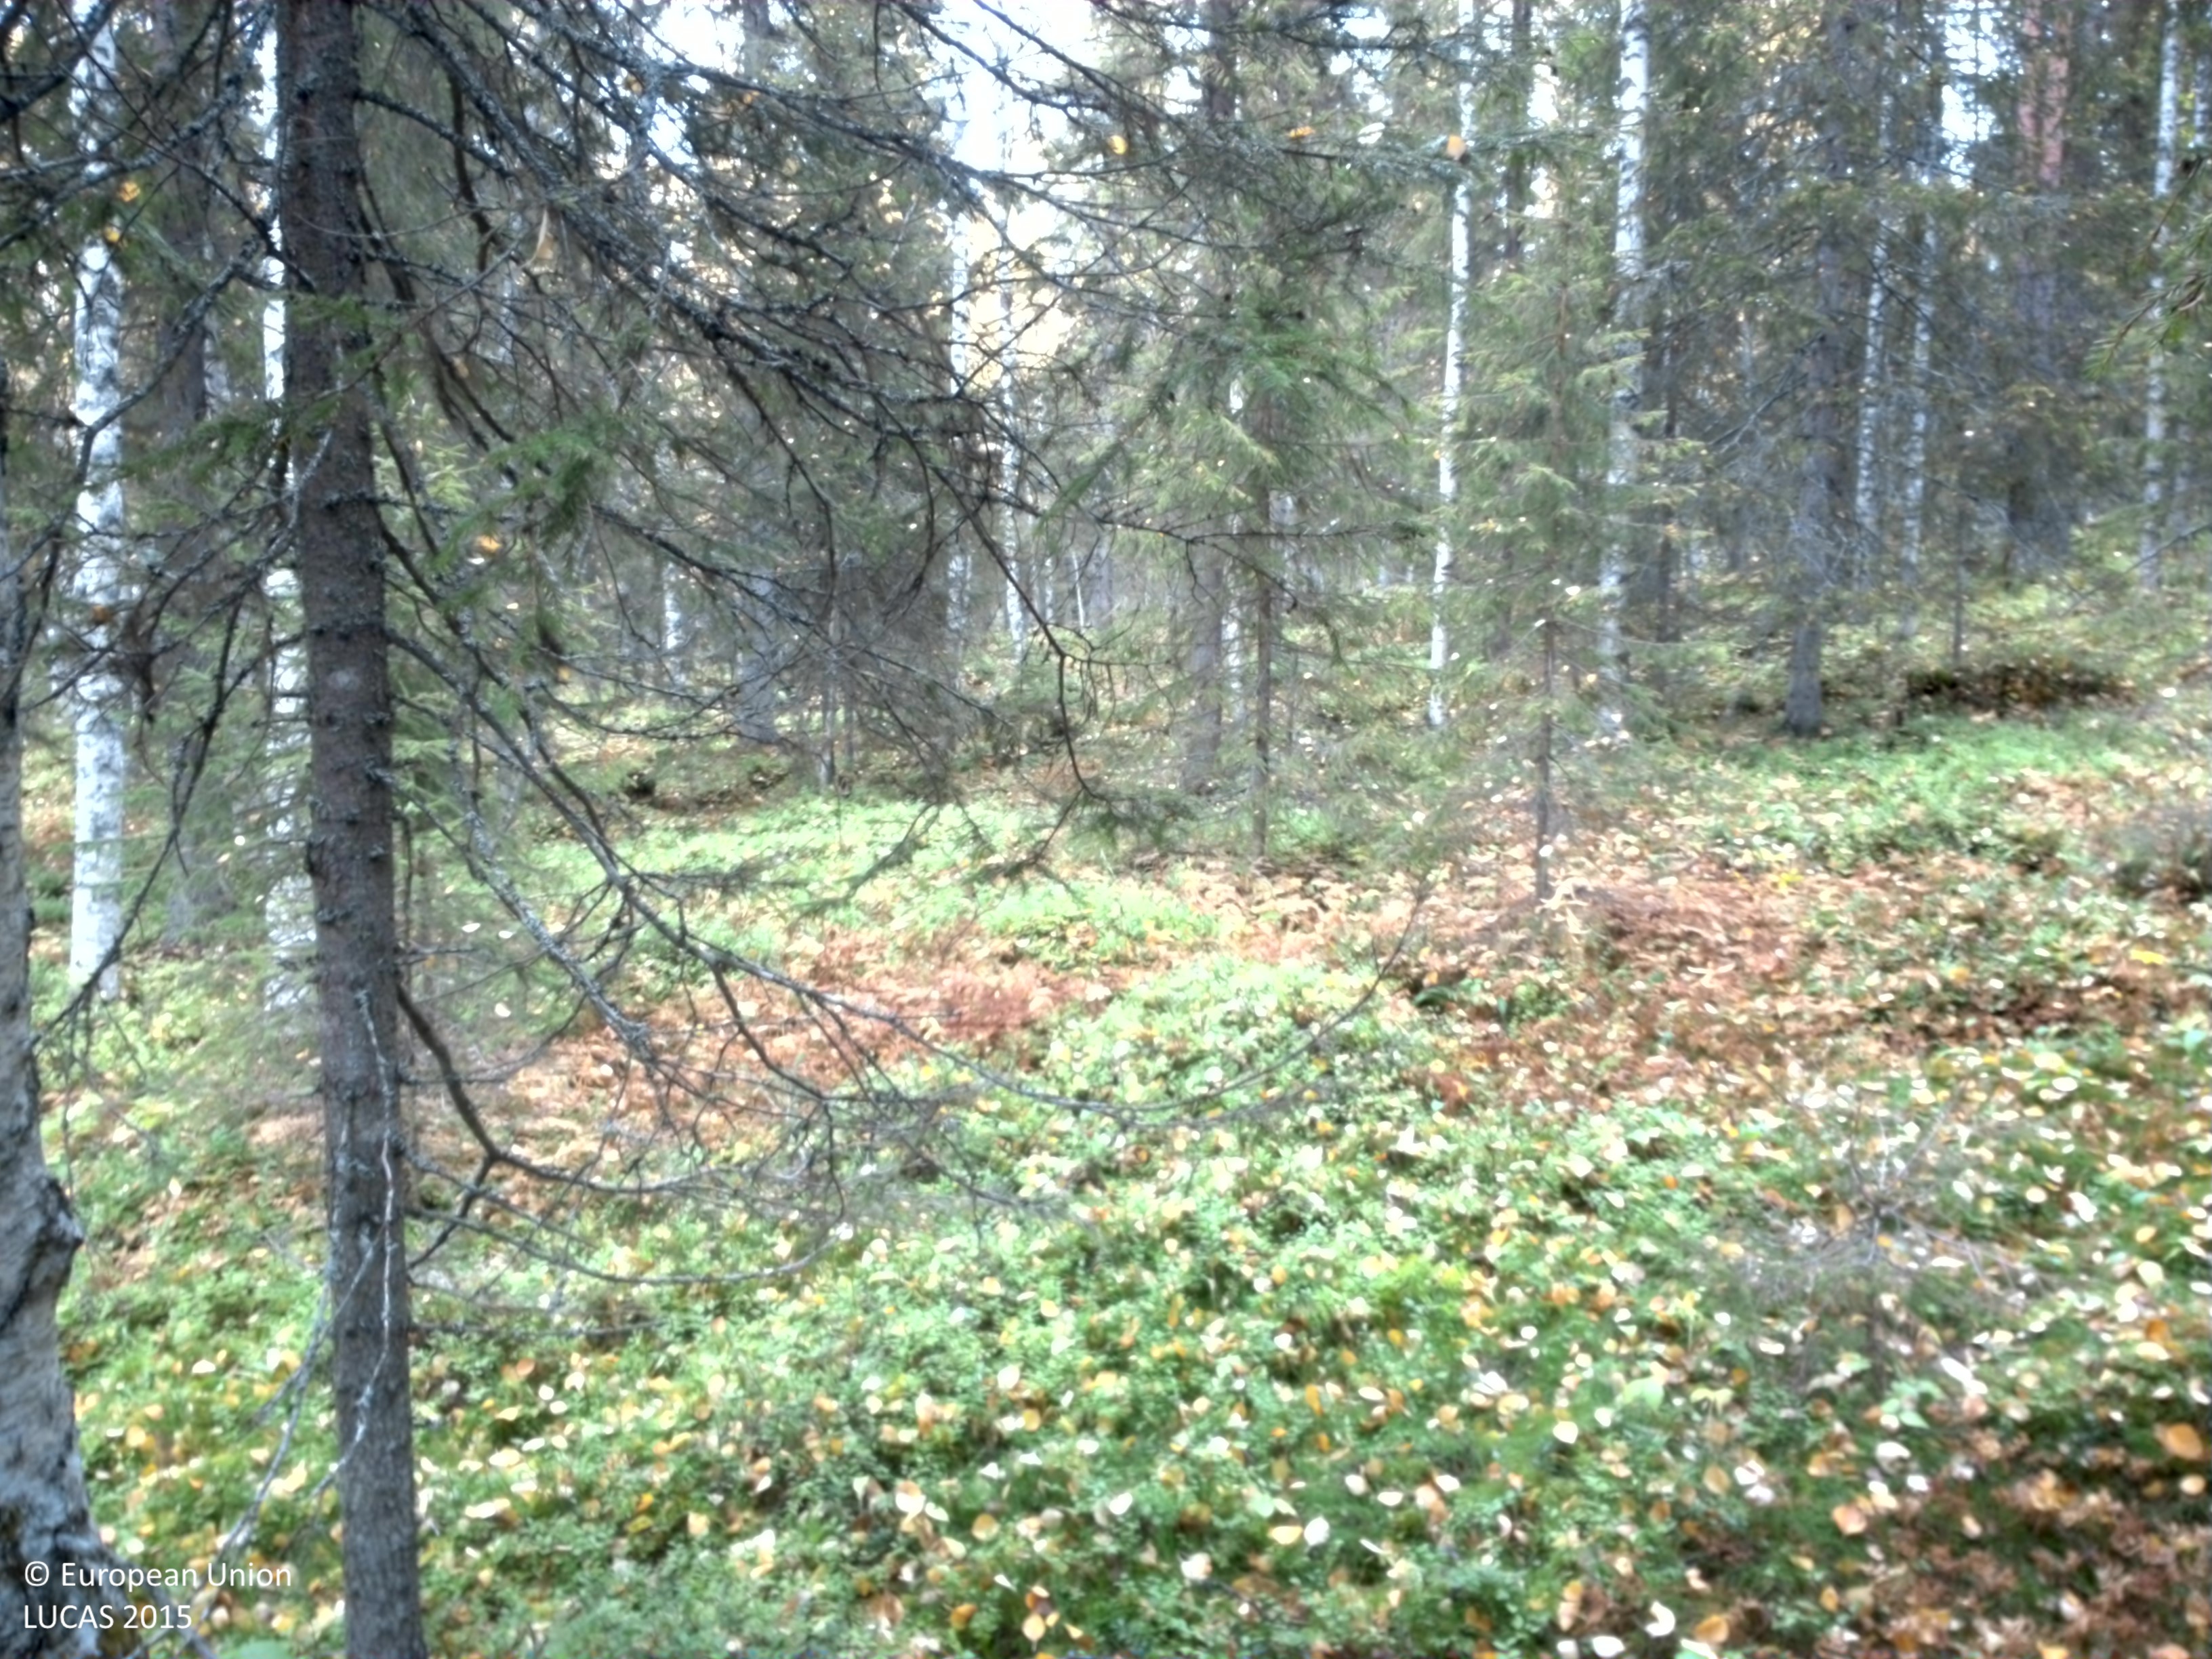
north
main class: Woodland
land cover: Spruce dominated mixed woodland
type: boreal forest
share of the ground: 50 - 75 %
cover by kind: coniferous forest trees 35 %, shrubs 20 %, herbaceous plants 20 %, broadleaved forest trees 15 %, lichens and mosses 10 %
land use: Forestry
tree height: > 5 m
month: September
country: SE
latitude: 65.1215
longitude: 17.6532
